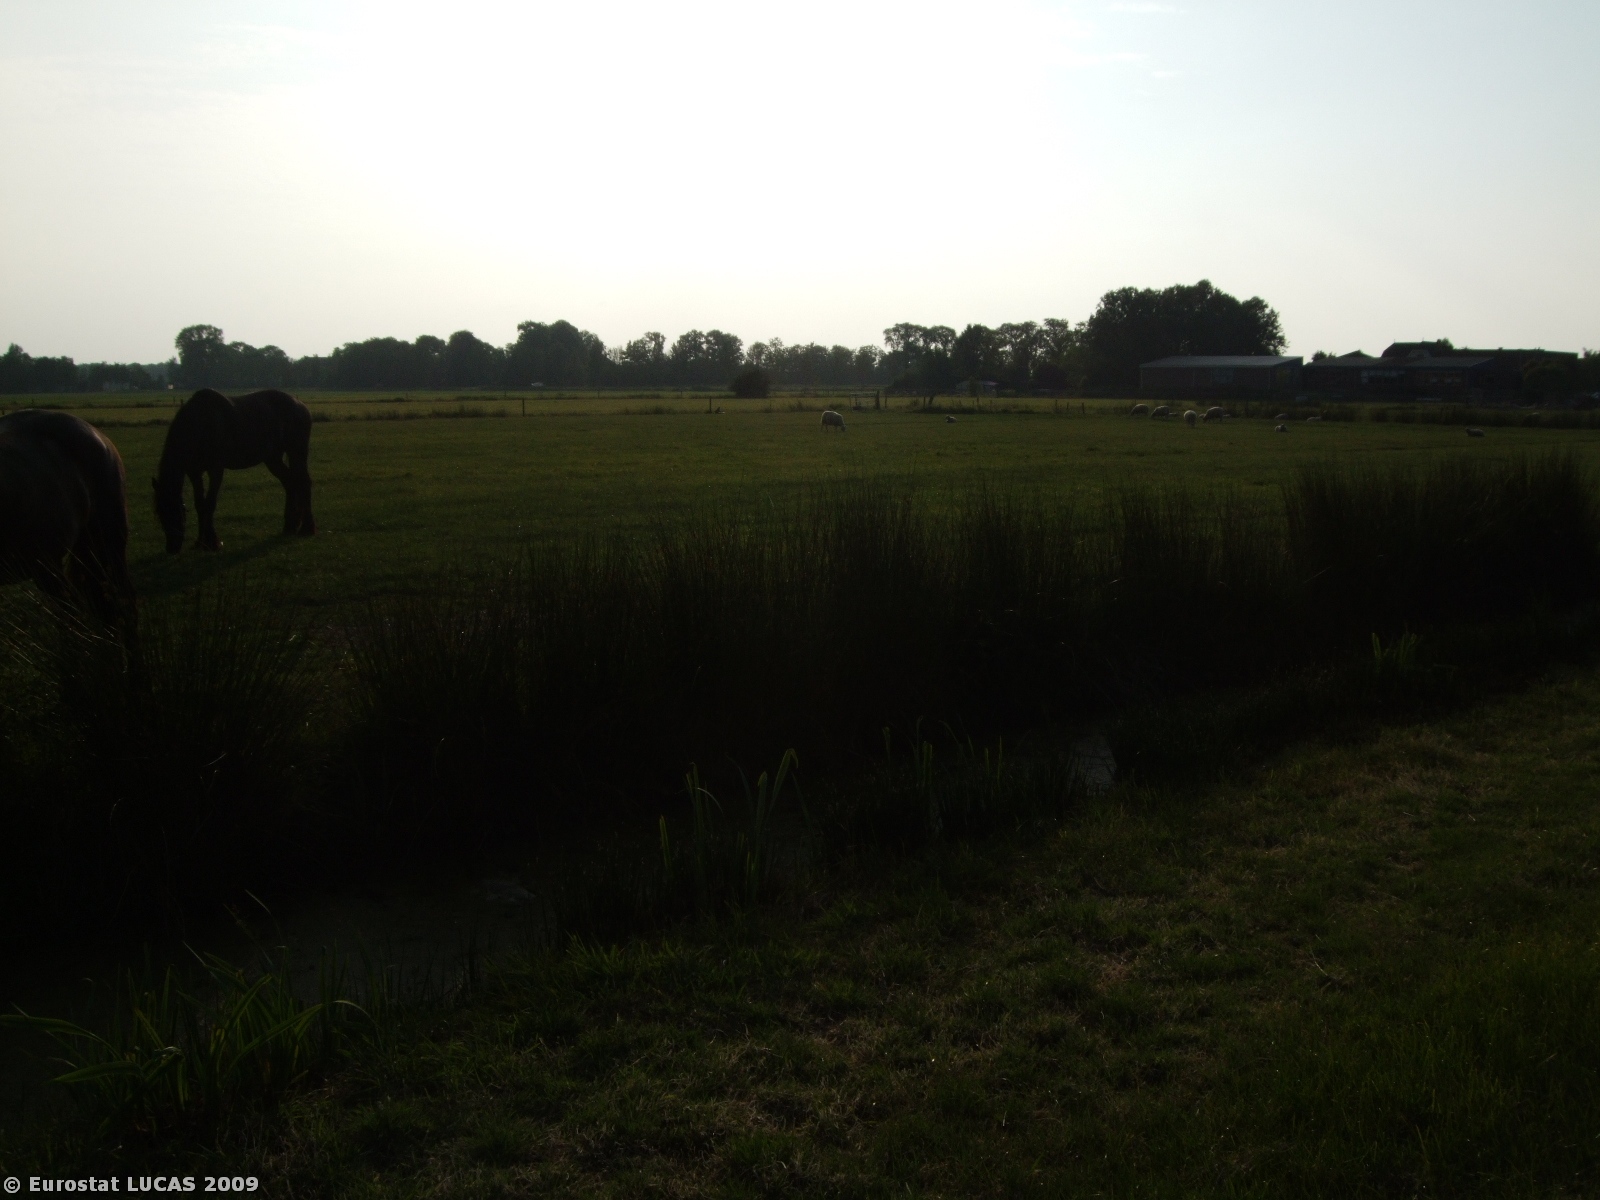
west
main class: Grassland
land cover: Grassland without tree/shrub cover
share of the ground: > 75 %
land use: Agriculture (excluding fallow land and kitchen gardens)
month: June
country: NL
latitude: 52.8916
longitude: 5.6439
